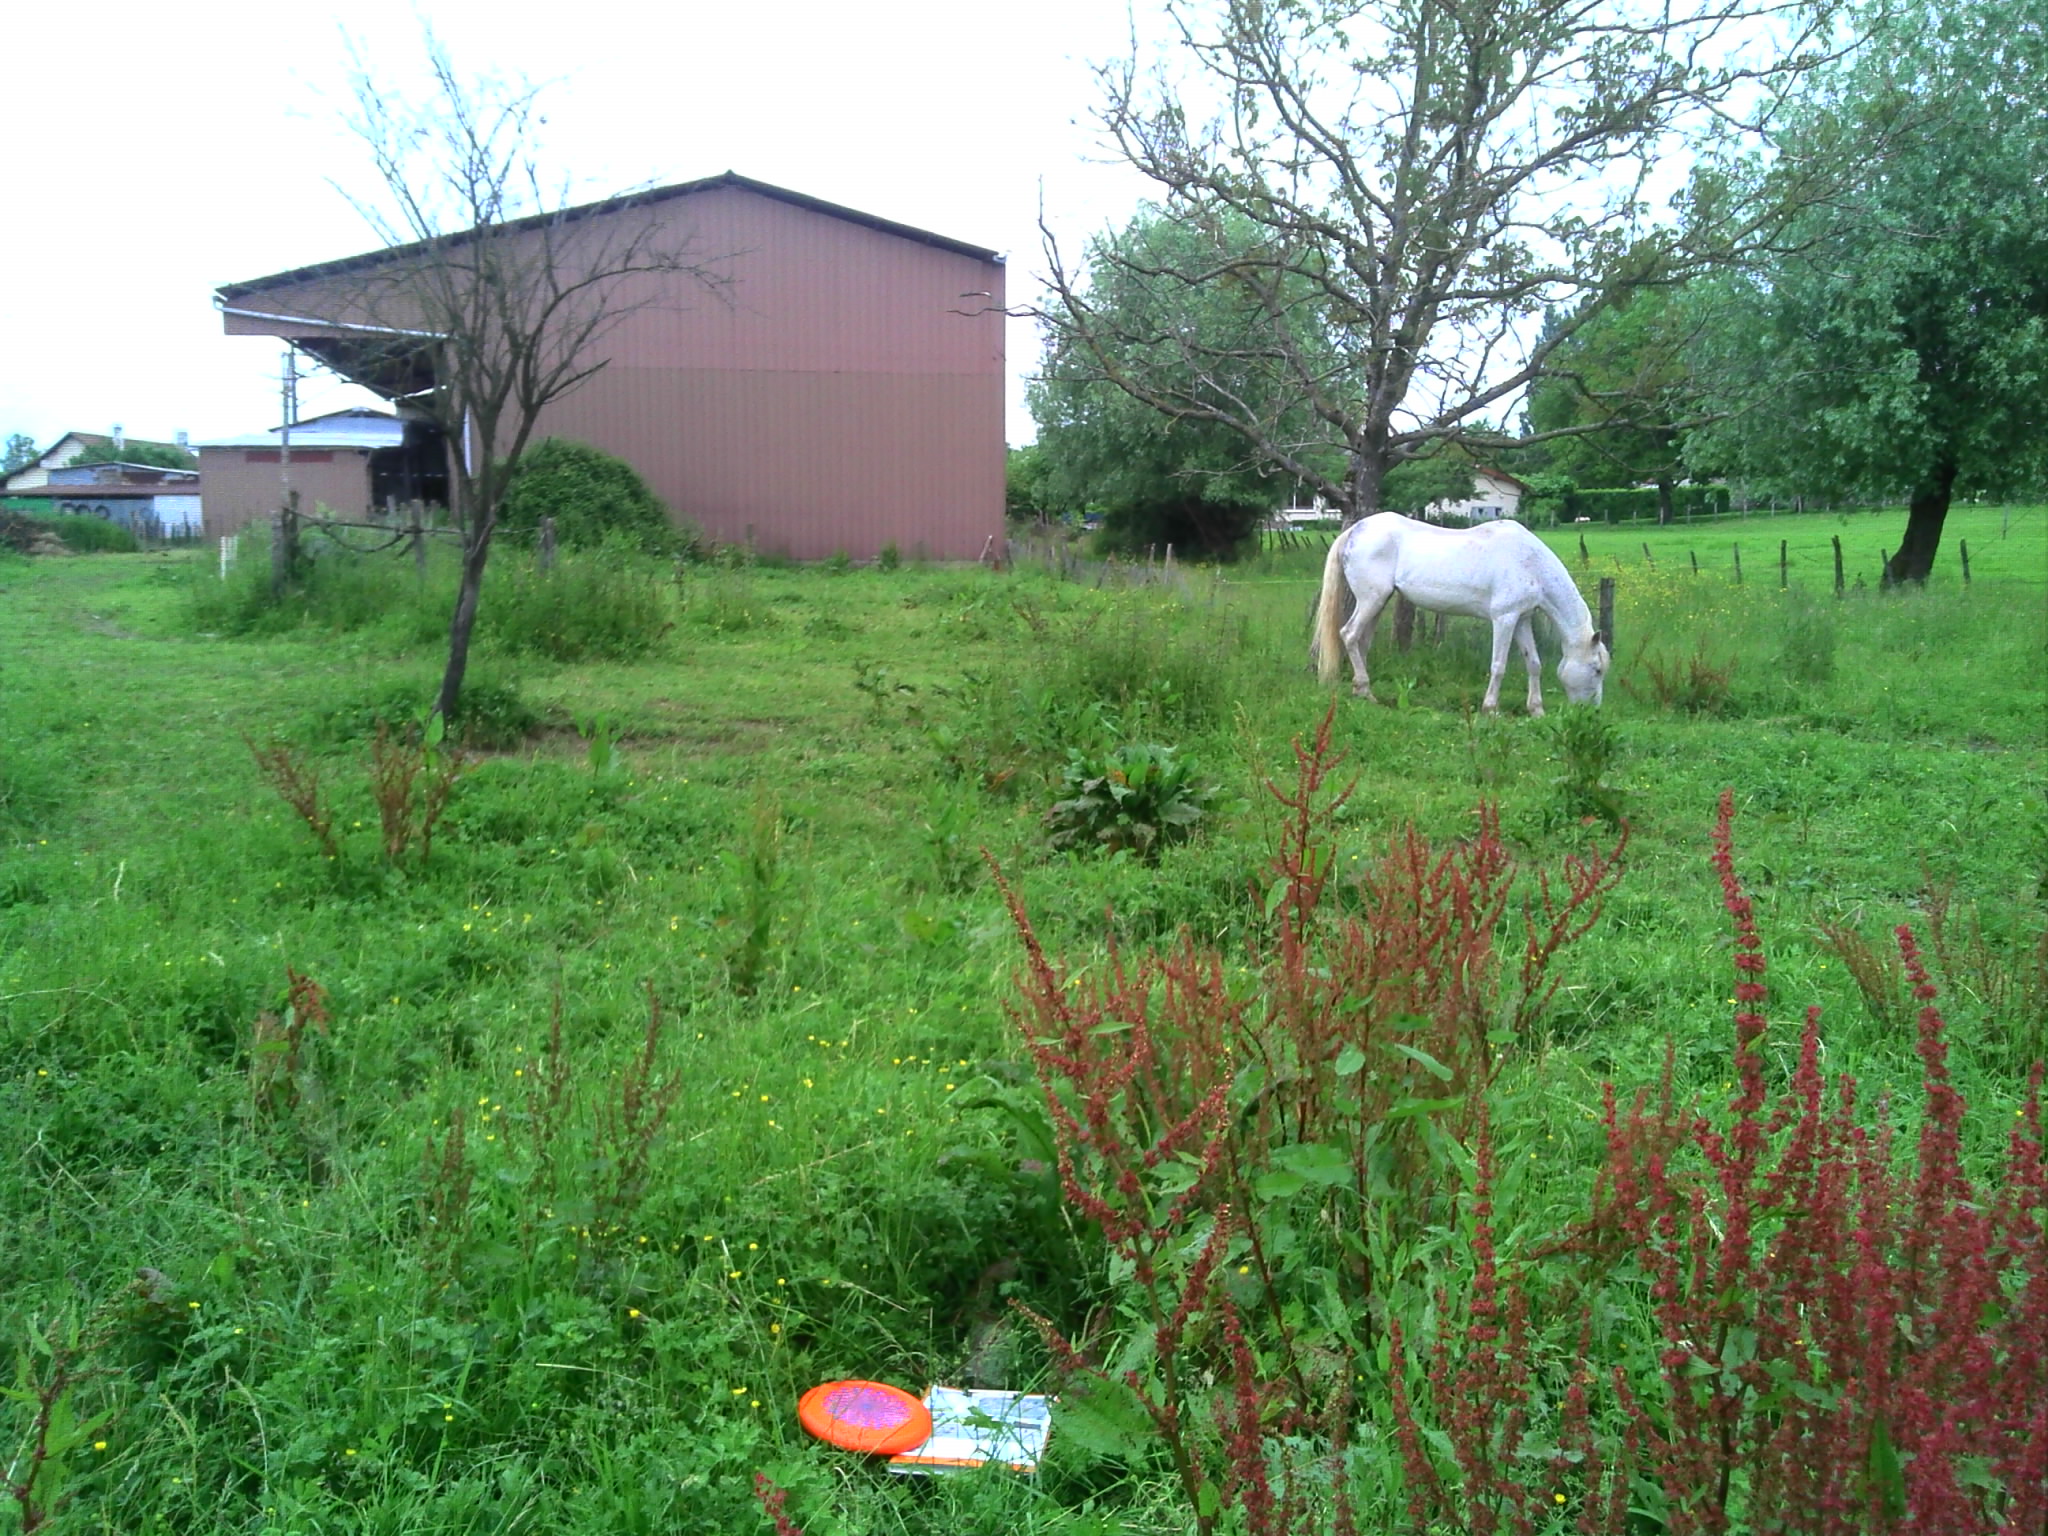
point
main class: Grassland
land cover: Grassland with sparse tree/shrub cover
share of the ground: > 75 %
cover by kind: herbaceous plants 95 %, broadleaved forest trees 5 %
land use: Agriculture (excluding fallow land and kitchen gardens)
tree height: < 5 m
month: May
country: FR
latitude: 46.5948
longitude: 5.3947
